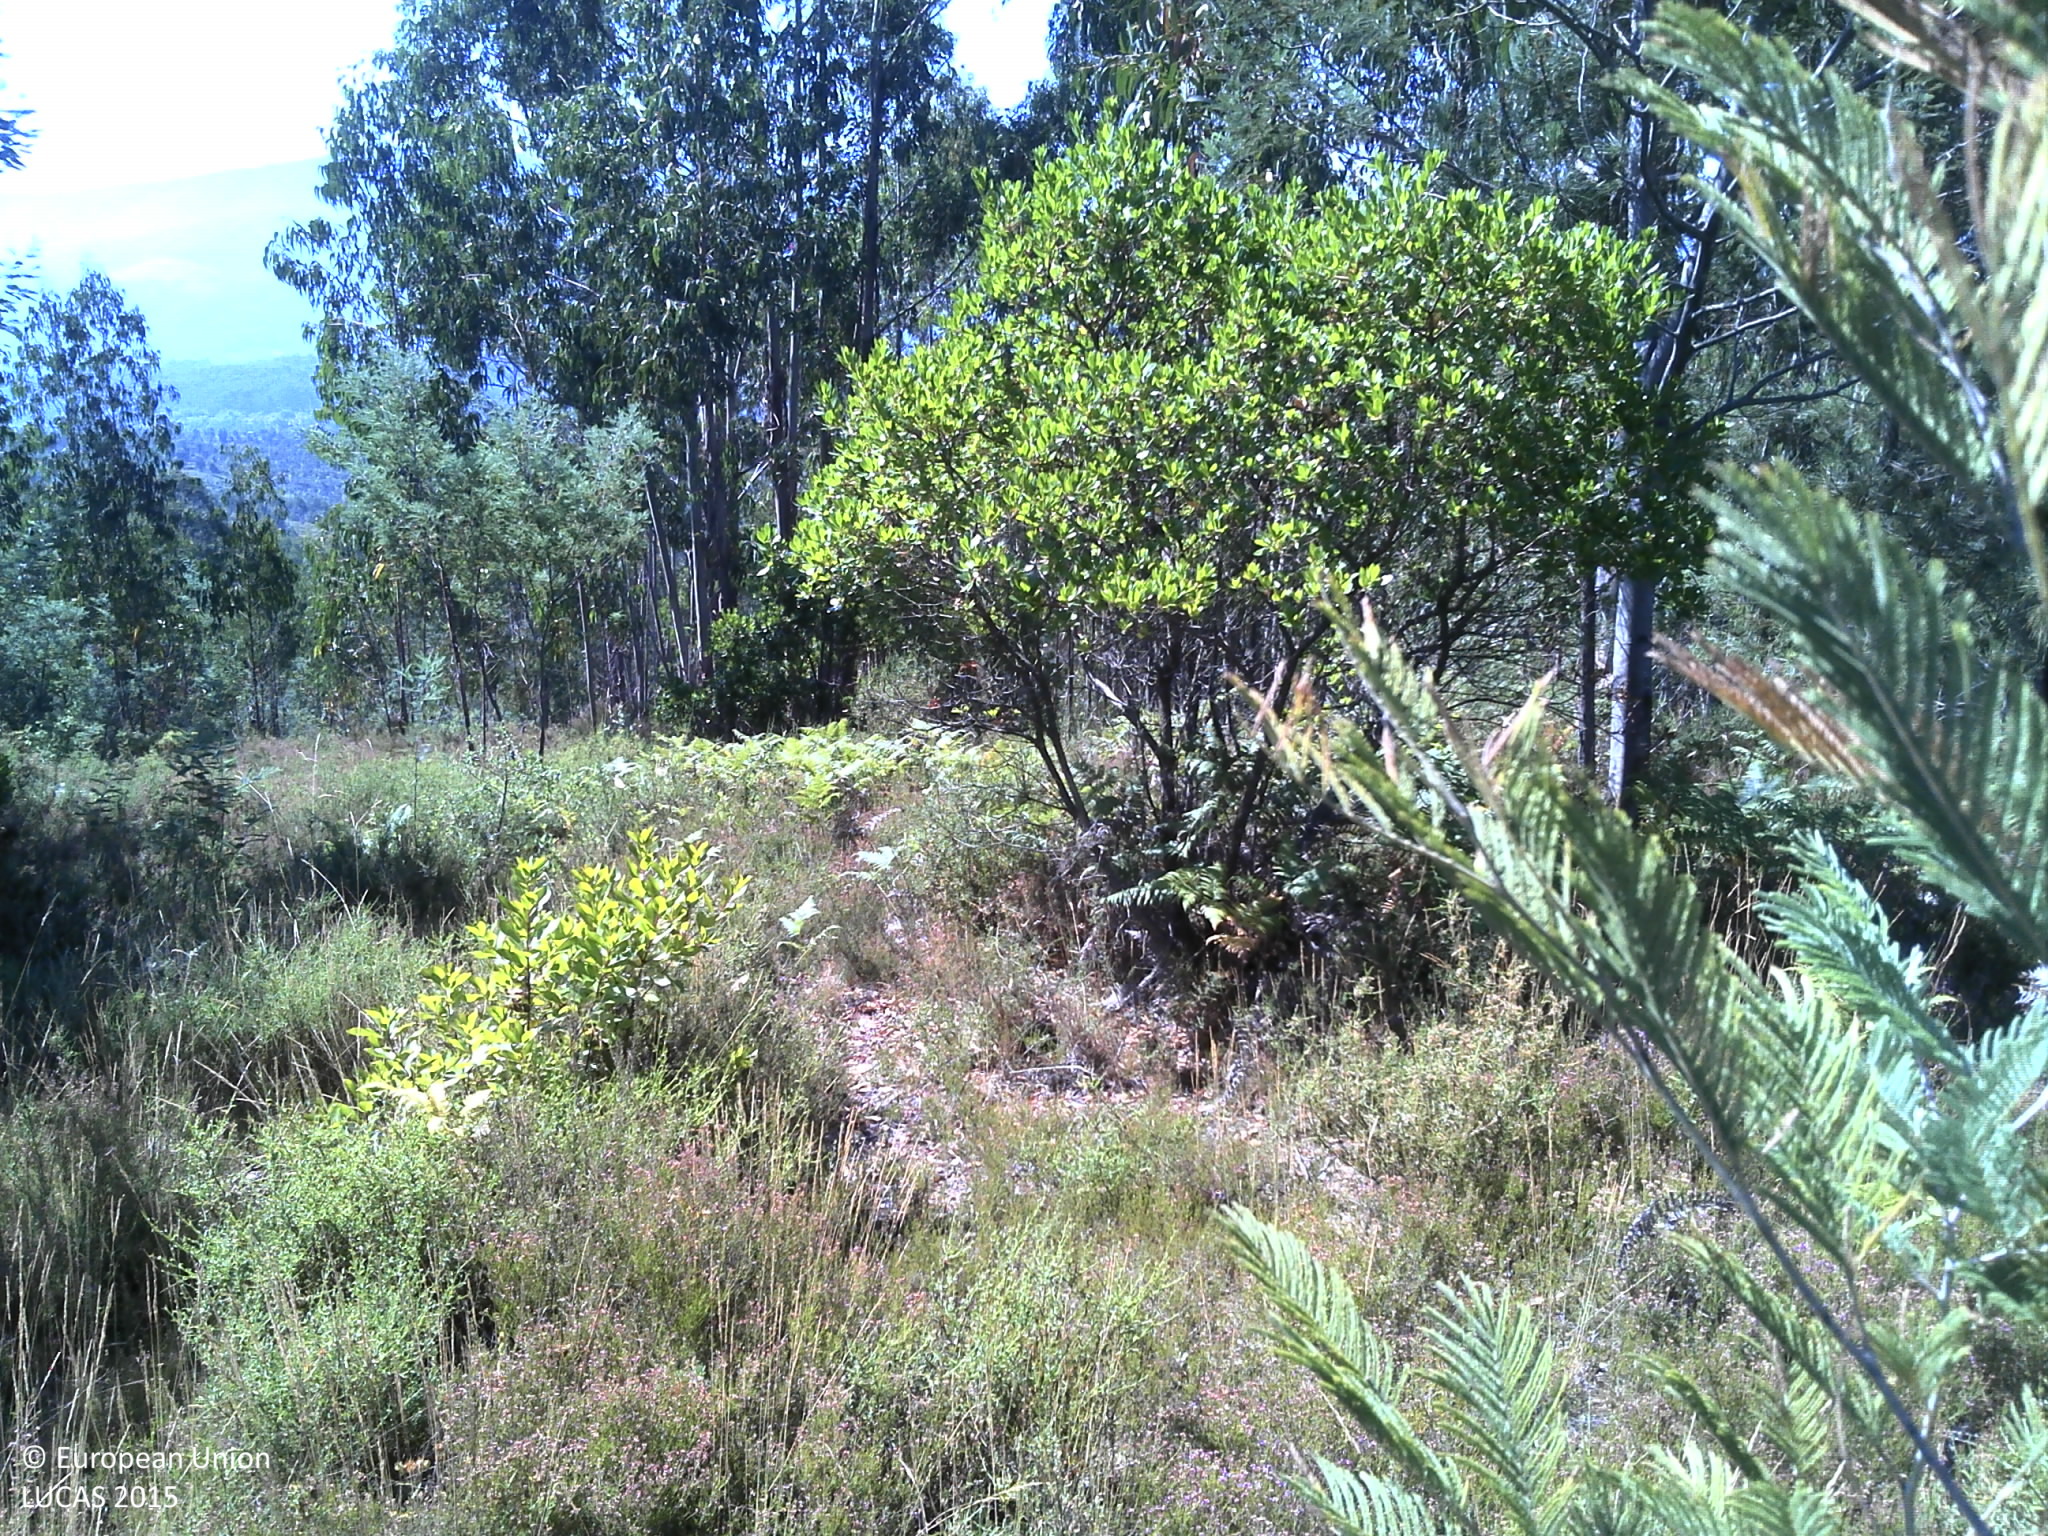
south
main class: Shrubland
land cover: Shrubland with sparse tree cover
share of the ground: > 75 %
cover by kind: shrubs 90 %, broadleaved forest trees 5 %, herbaceous plants 5 %
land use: Semi-natural and natural areas not in use
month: June
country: PT
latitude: 40.1676
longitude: -8.2426
